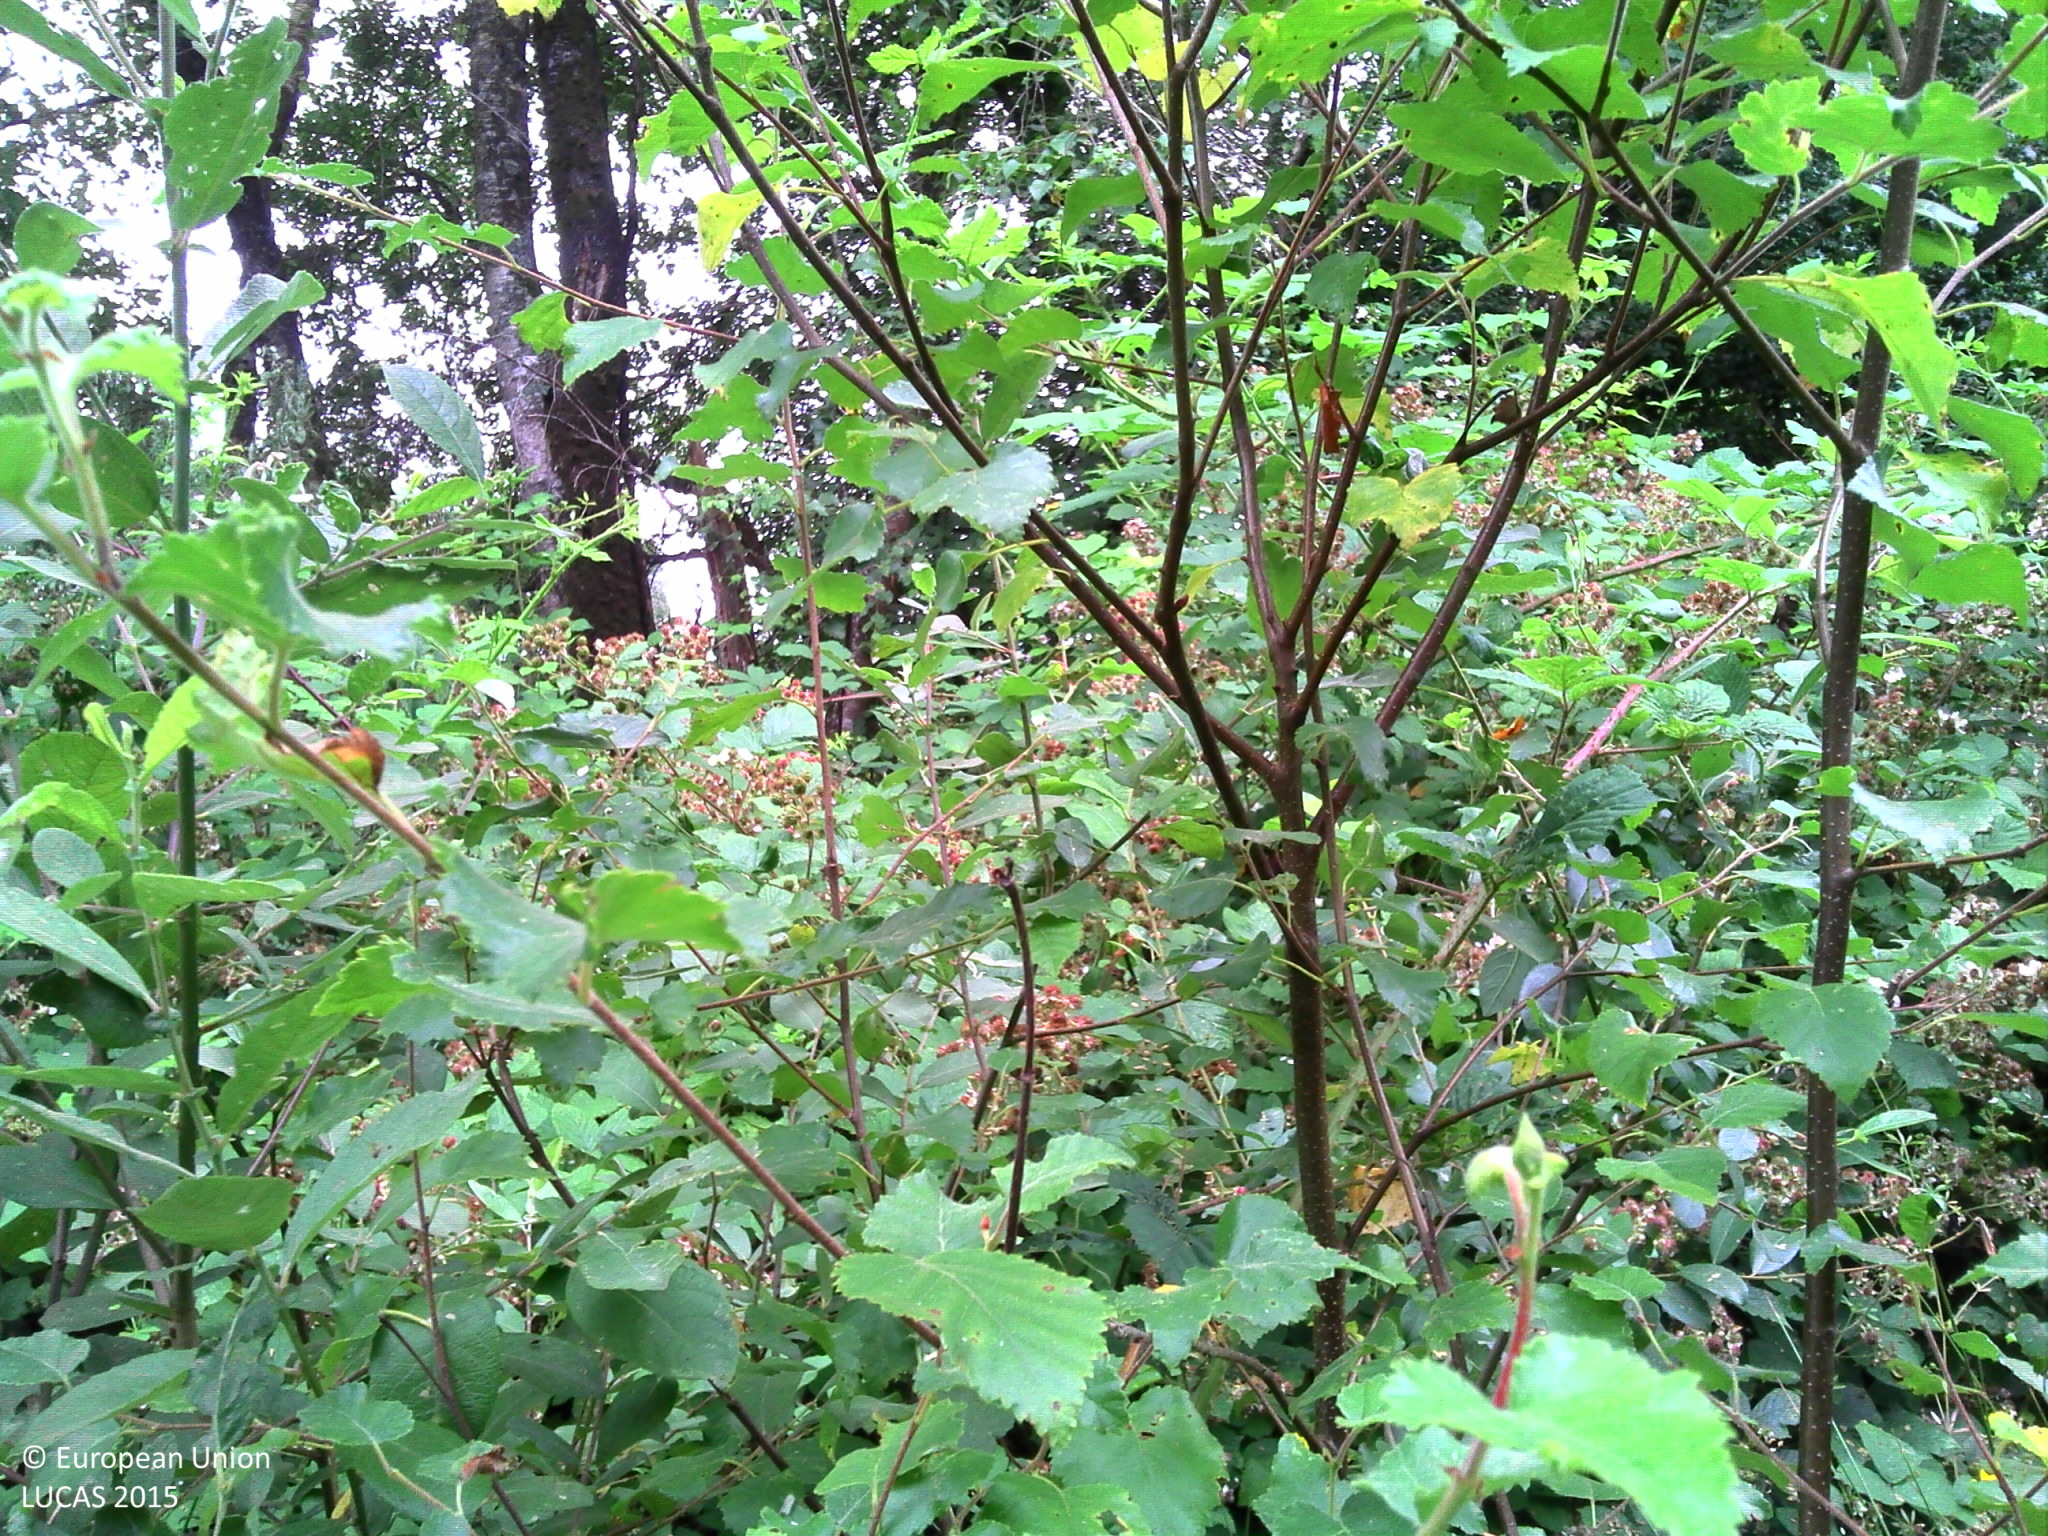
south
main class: Cropland
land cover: Common wheat
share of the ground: > 75 %
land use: Agriculture (excluding fallow land and kitchen gardens)
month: July
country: FR
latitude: 48.1472
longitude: -3.5596
